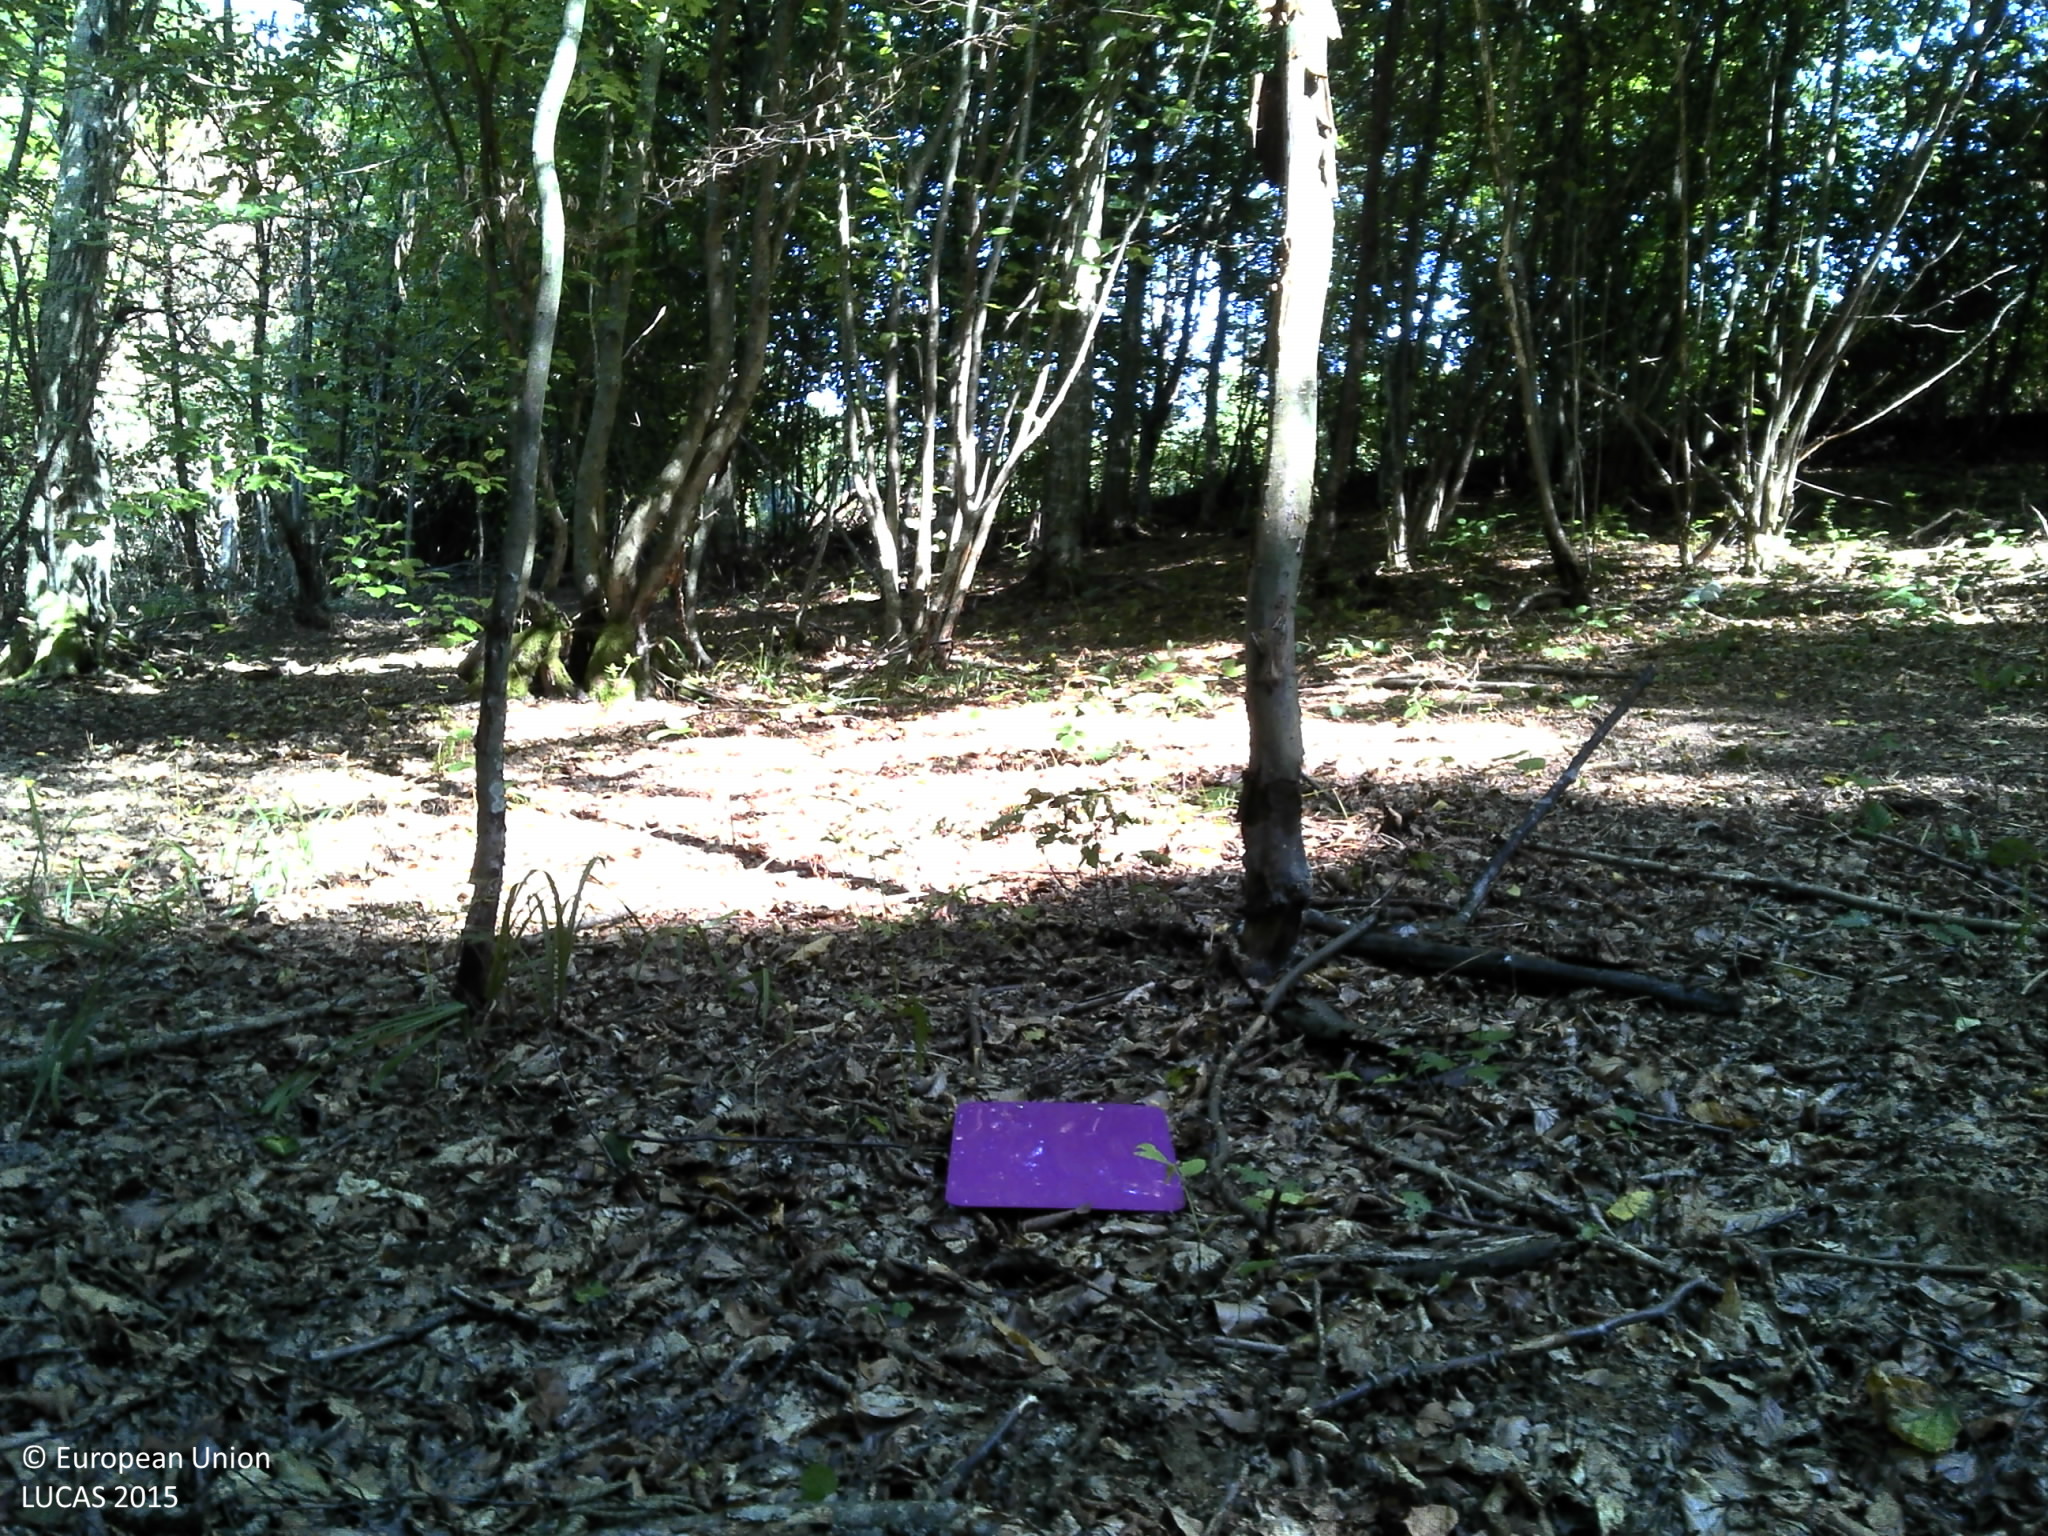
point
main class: Woodland
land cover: Broadleaved woodland
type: mesophytic deciduous forest
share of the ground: > 75 %
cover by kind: broadleaved forest trees 100 %
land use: Forestry
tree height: > 5 m
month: August
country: HR
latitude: 45.2190
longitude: 15.7900
